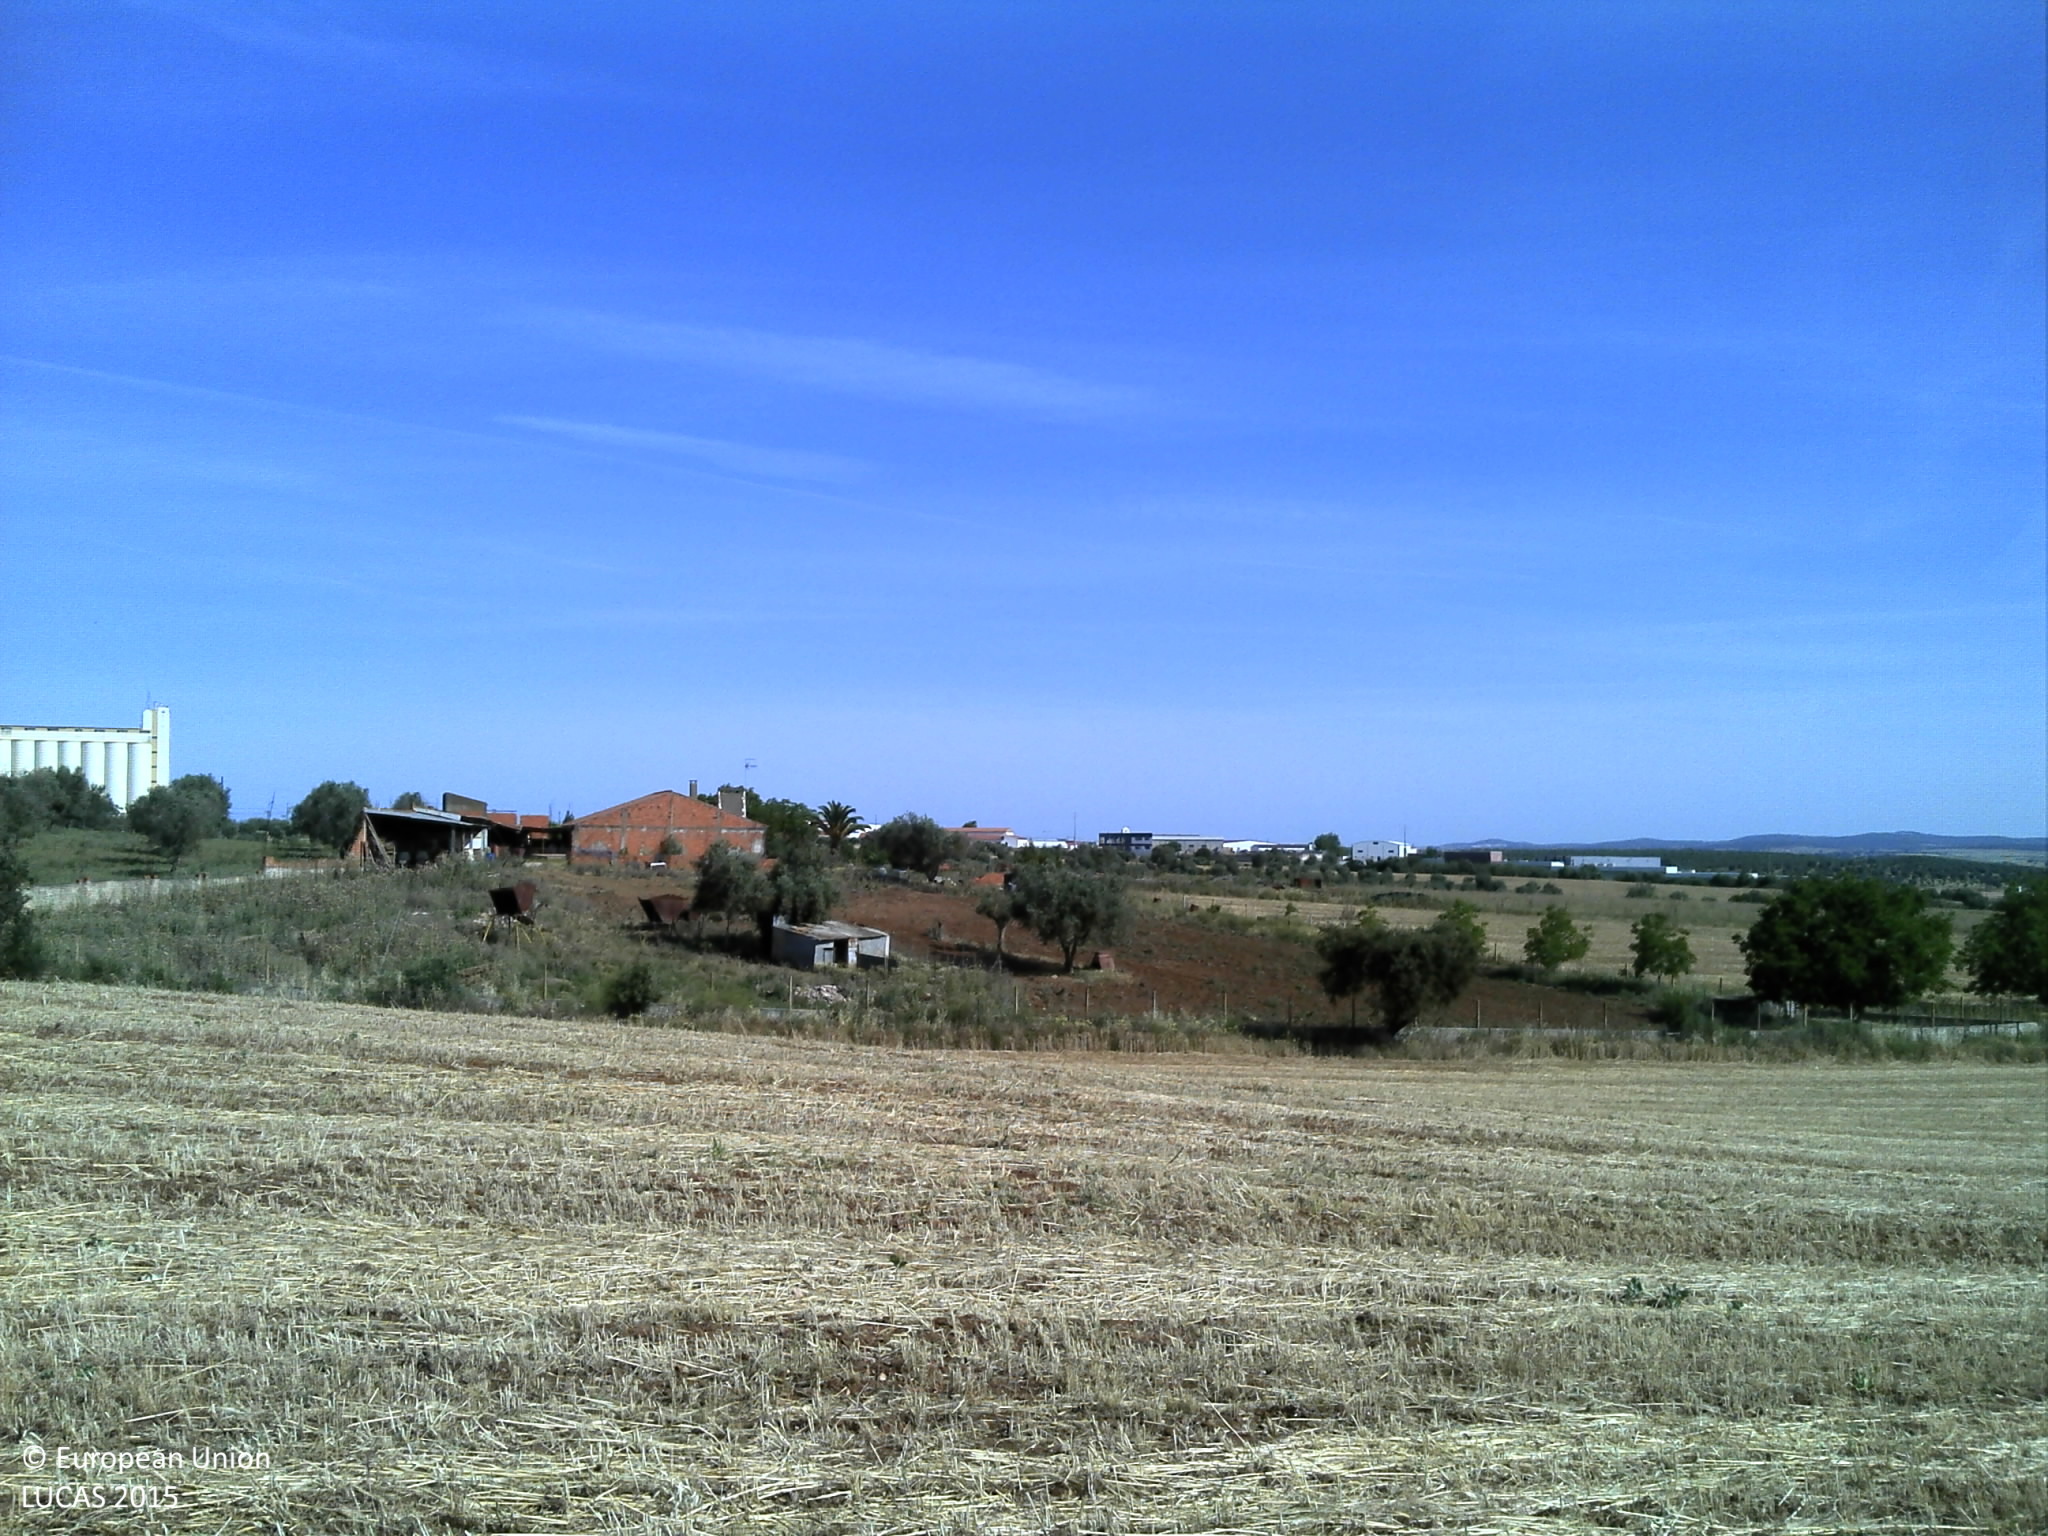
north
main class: Cropland
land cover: Triticale
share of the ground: < 10 %
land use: Agriculture (excluding fallow land and kitchen gardens)
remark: Harvested field
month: May
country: PT
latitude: 39.0429
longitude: -7.6381
